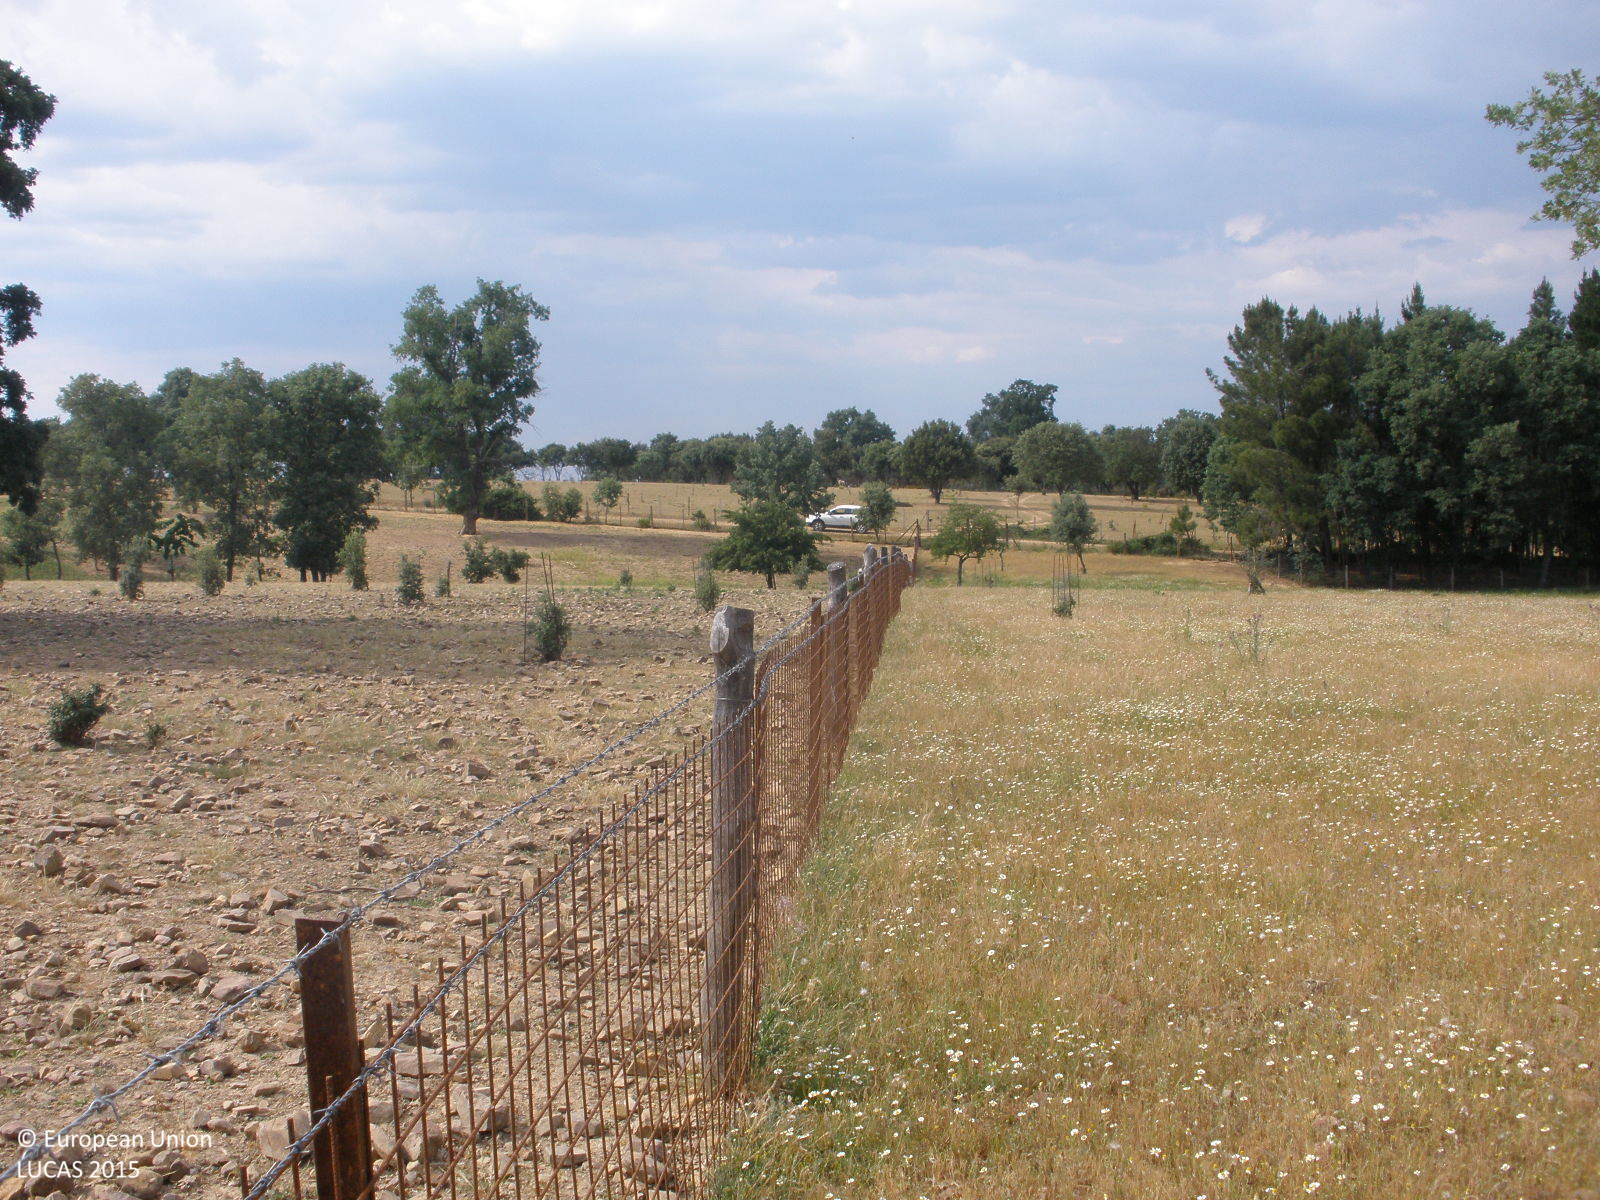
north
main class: Grassland
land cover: Grassland with sparse tree/shrub cover
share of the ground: > 75 %
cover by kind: herbaceous plants 80 %, unconsolidated bare surface 15 %, broadleaved forest trees 5 %
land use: Agriculture (excluding fallow land and kitchen gardens)
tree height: < 5 m
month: June
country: ES
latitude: 40.5570
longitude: -6.3713
